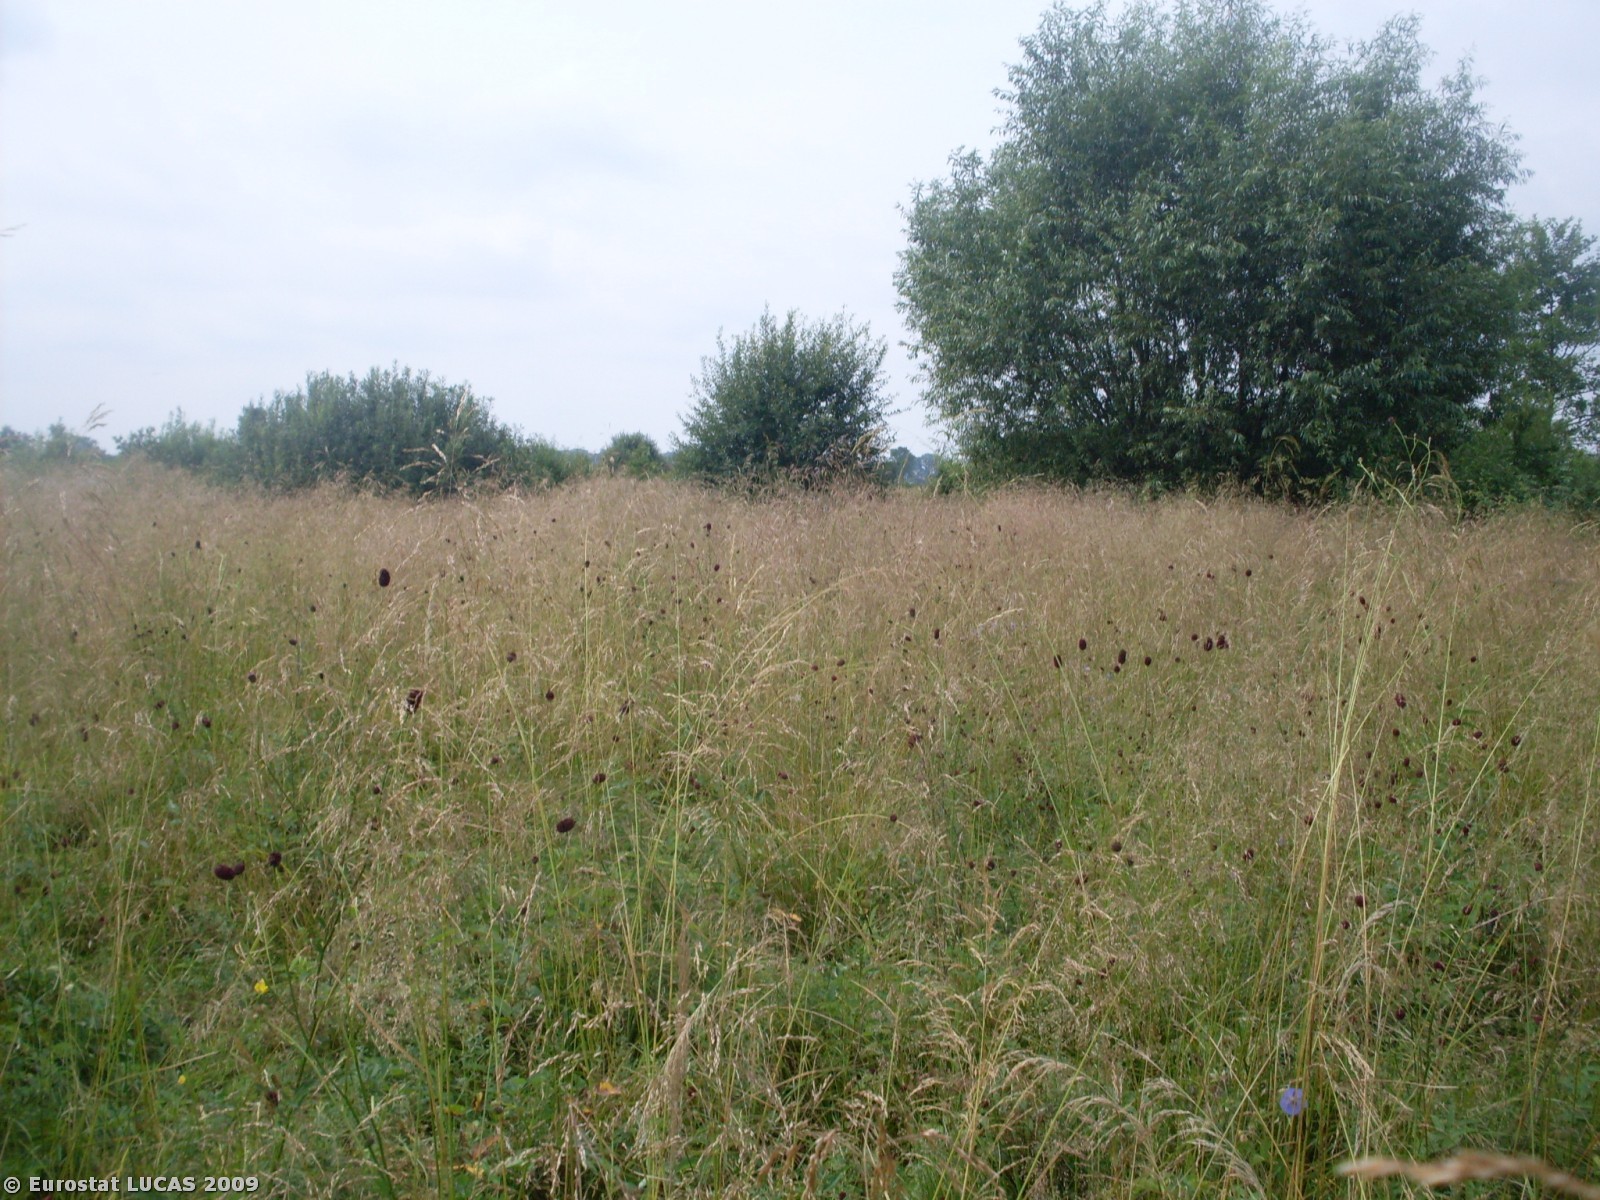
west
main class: Grassland
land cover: Grassland without tree/shrub cover
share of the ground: > 75 %
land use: Agriculture (excluding fallow land and kitchen gardens)
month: August
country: PL
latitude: 50.1089
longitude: 20.5675
